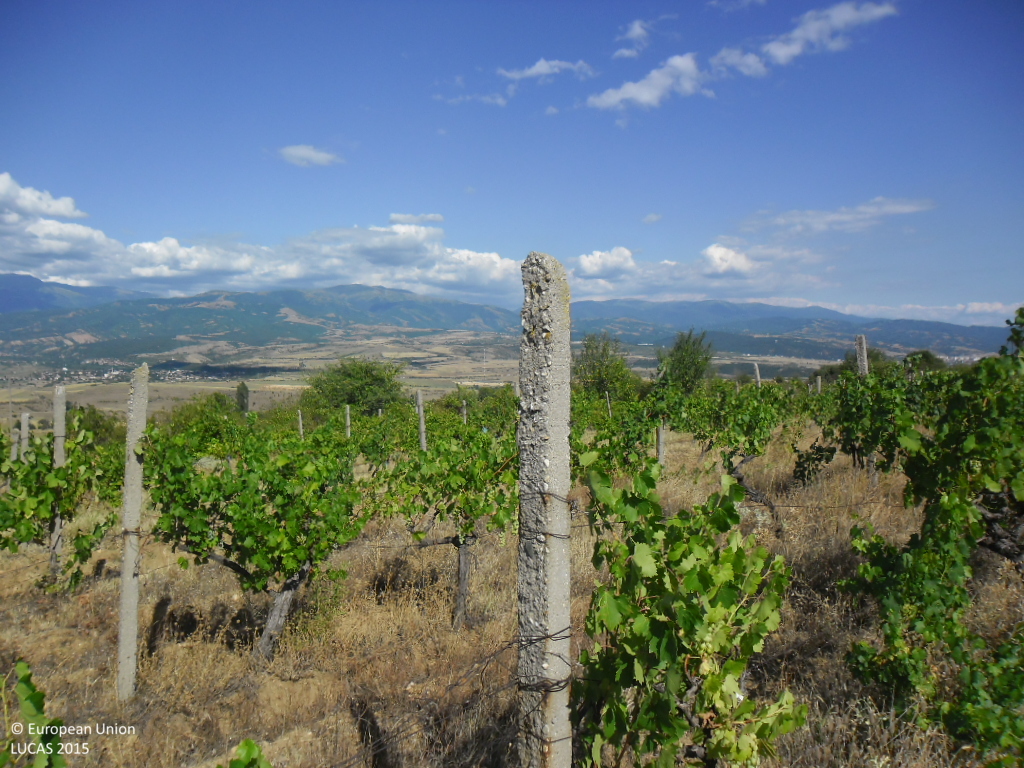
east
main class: Cropland
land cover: Vineyards
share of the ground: 50 - 75 %
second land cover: Spontaneously vegetated surfaces
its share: > 75 %
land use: Agriculture (excluding fallow land and kitchen gardens)
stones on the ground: < 10 %
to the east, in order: Vineyards; Spontaneously vegetated surfaces; Abandoned hedges; Vineyards; Tracks; Grassland without tree/shrub cover
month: August
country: BG
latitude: 42.0483
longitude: 23.0115
